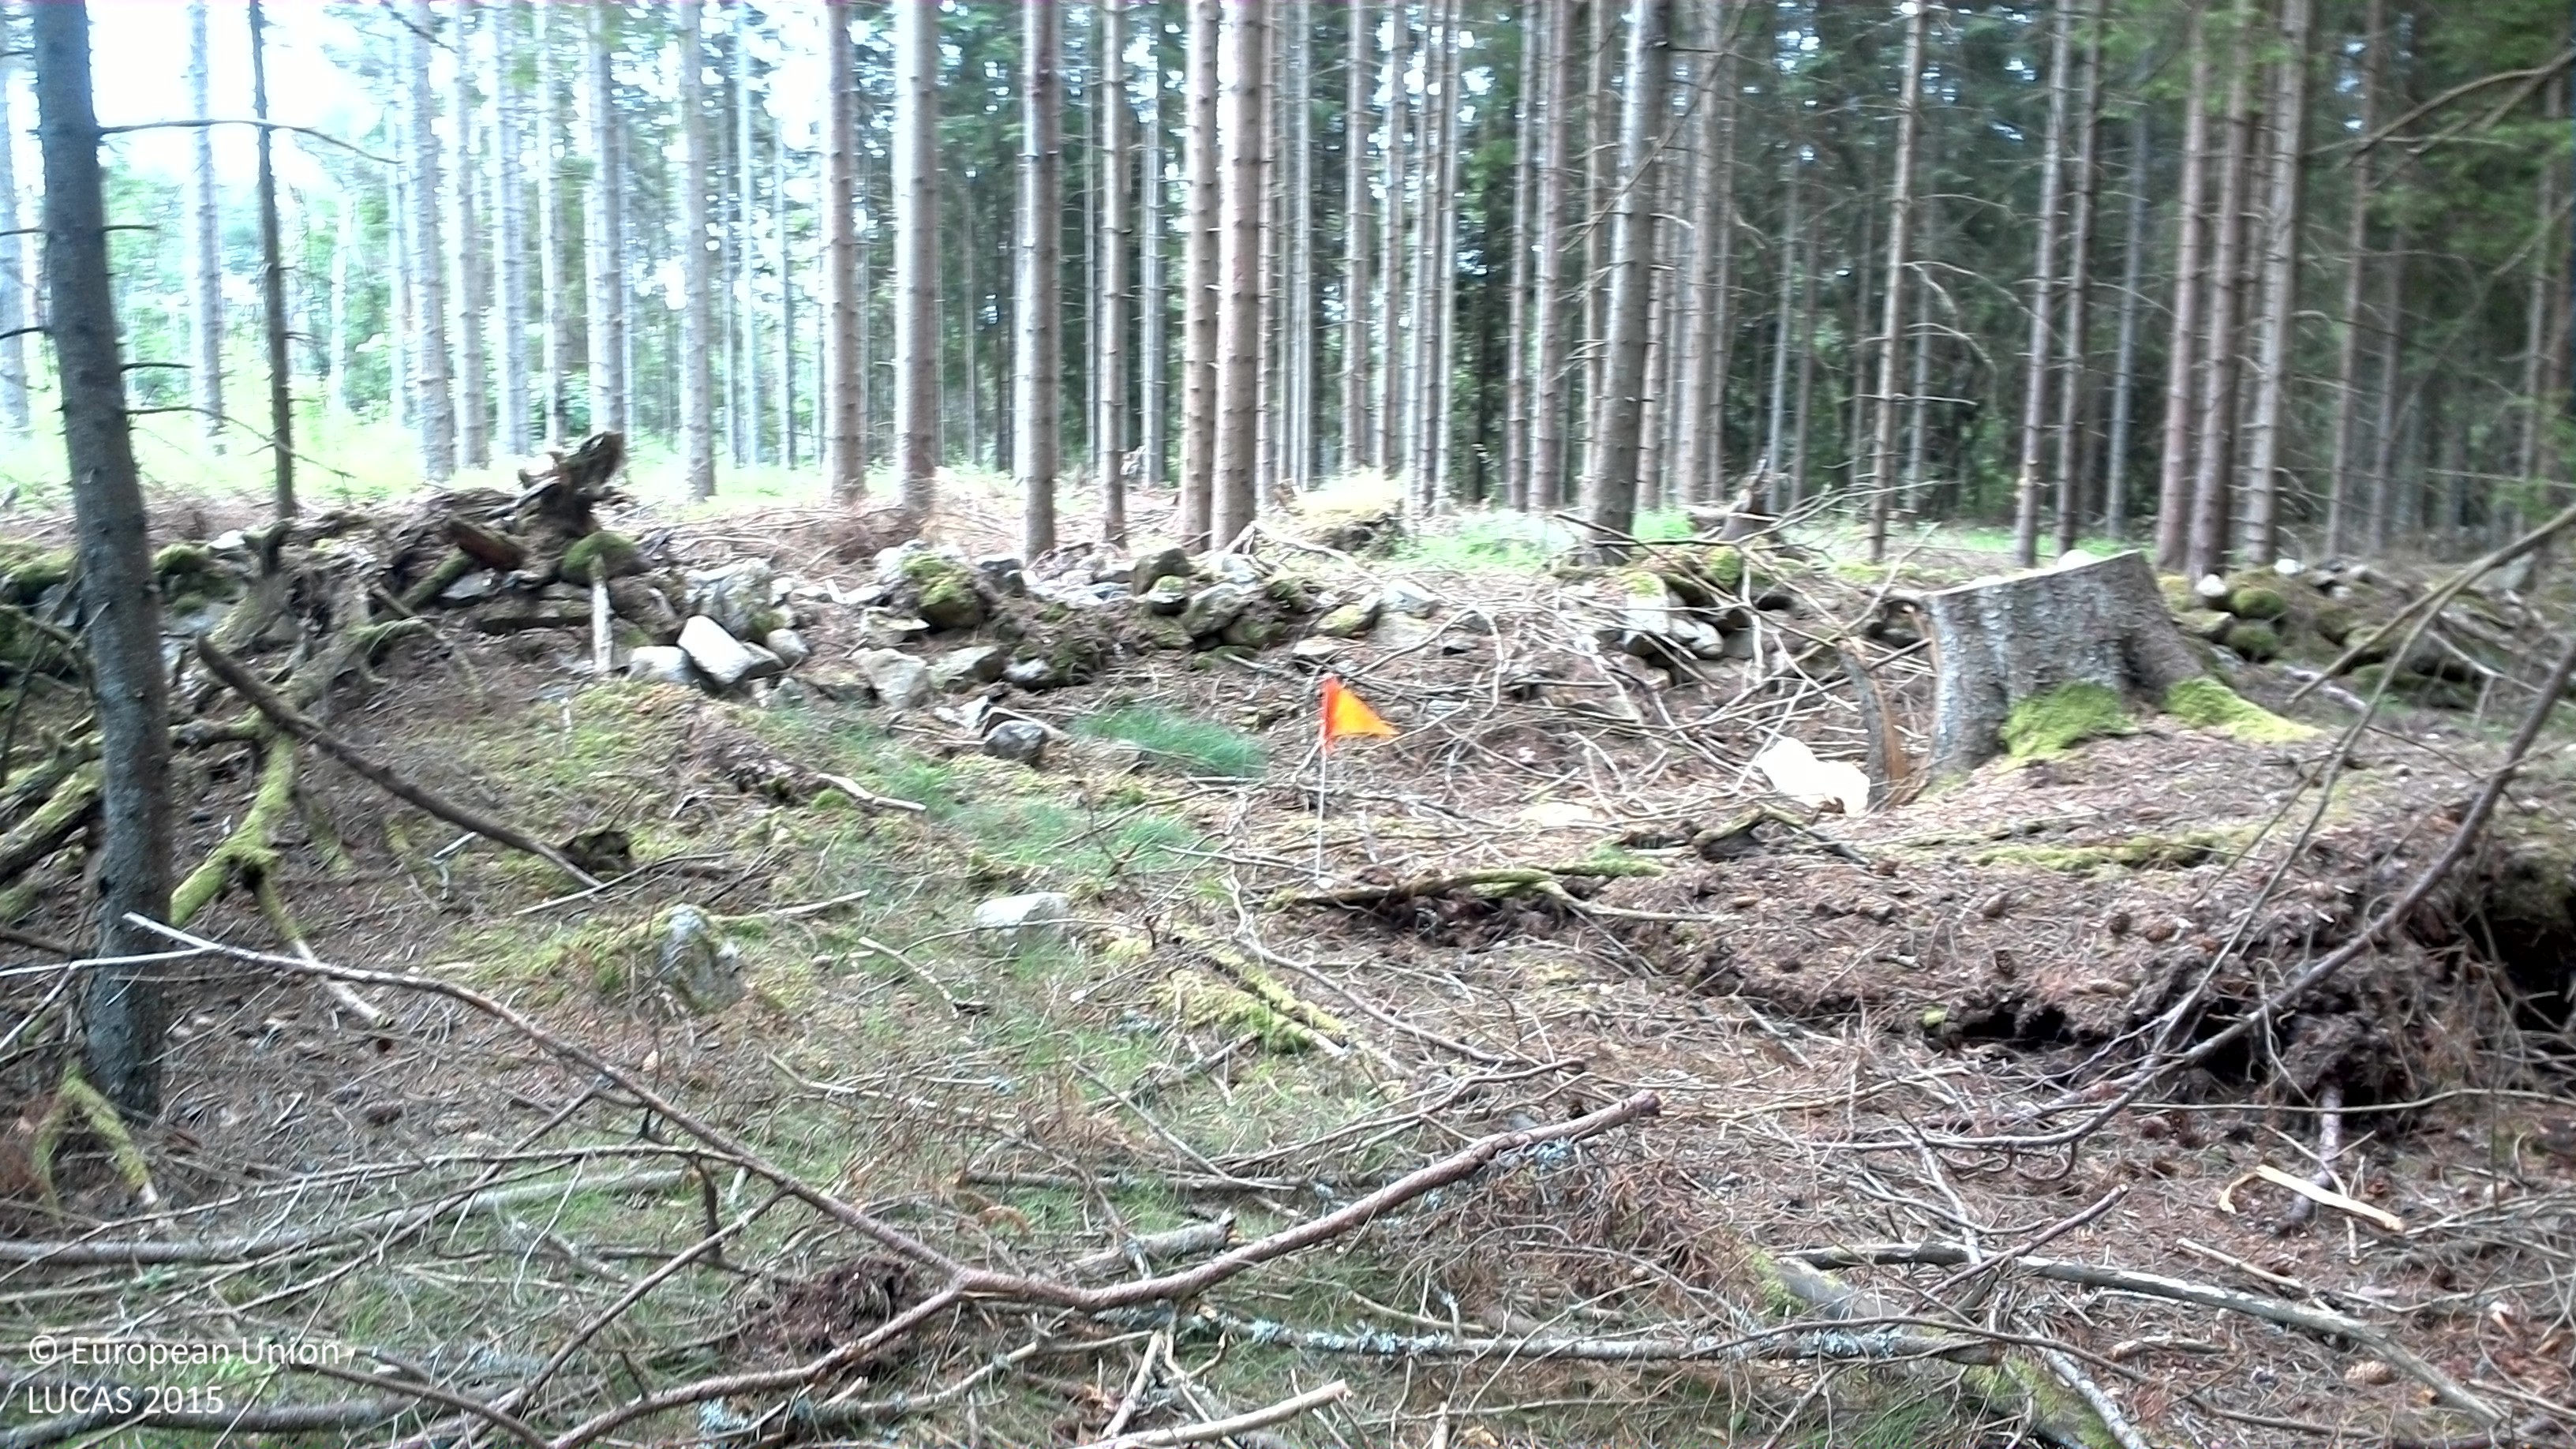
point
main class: Woodland
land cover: Spruce dominated coniferous woodland
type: boreal forest
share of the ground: 50 - 75 %
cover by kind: coniferous forest trees 70 %, lichens and mosses 25 %, herbaceous plants 5 %
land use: Forestry
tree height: > 5 m
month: July
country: SE
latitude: 56.5150
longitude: 14.7270
